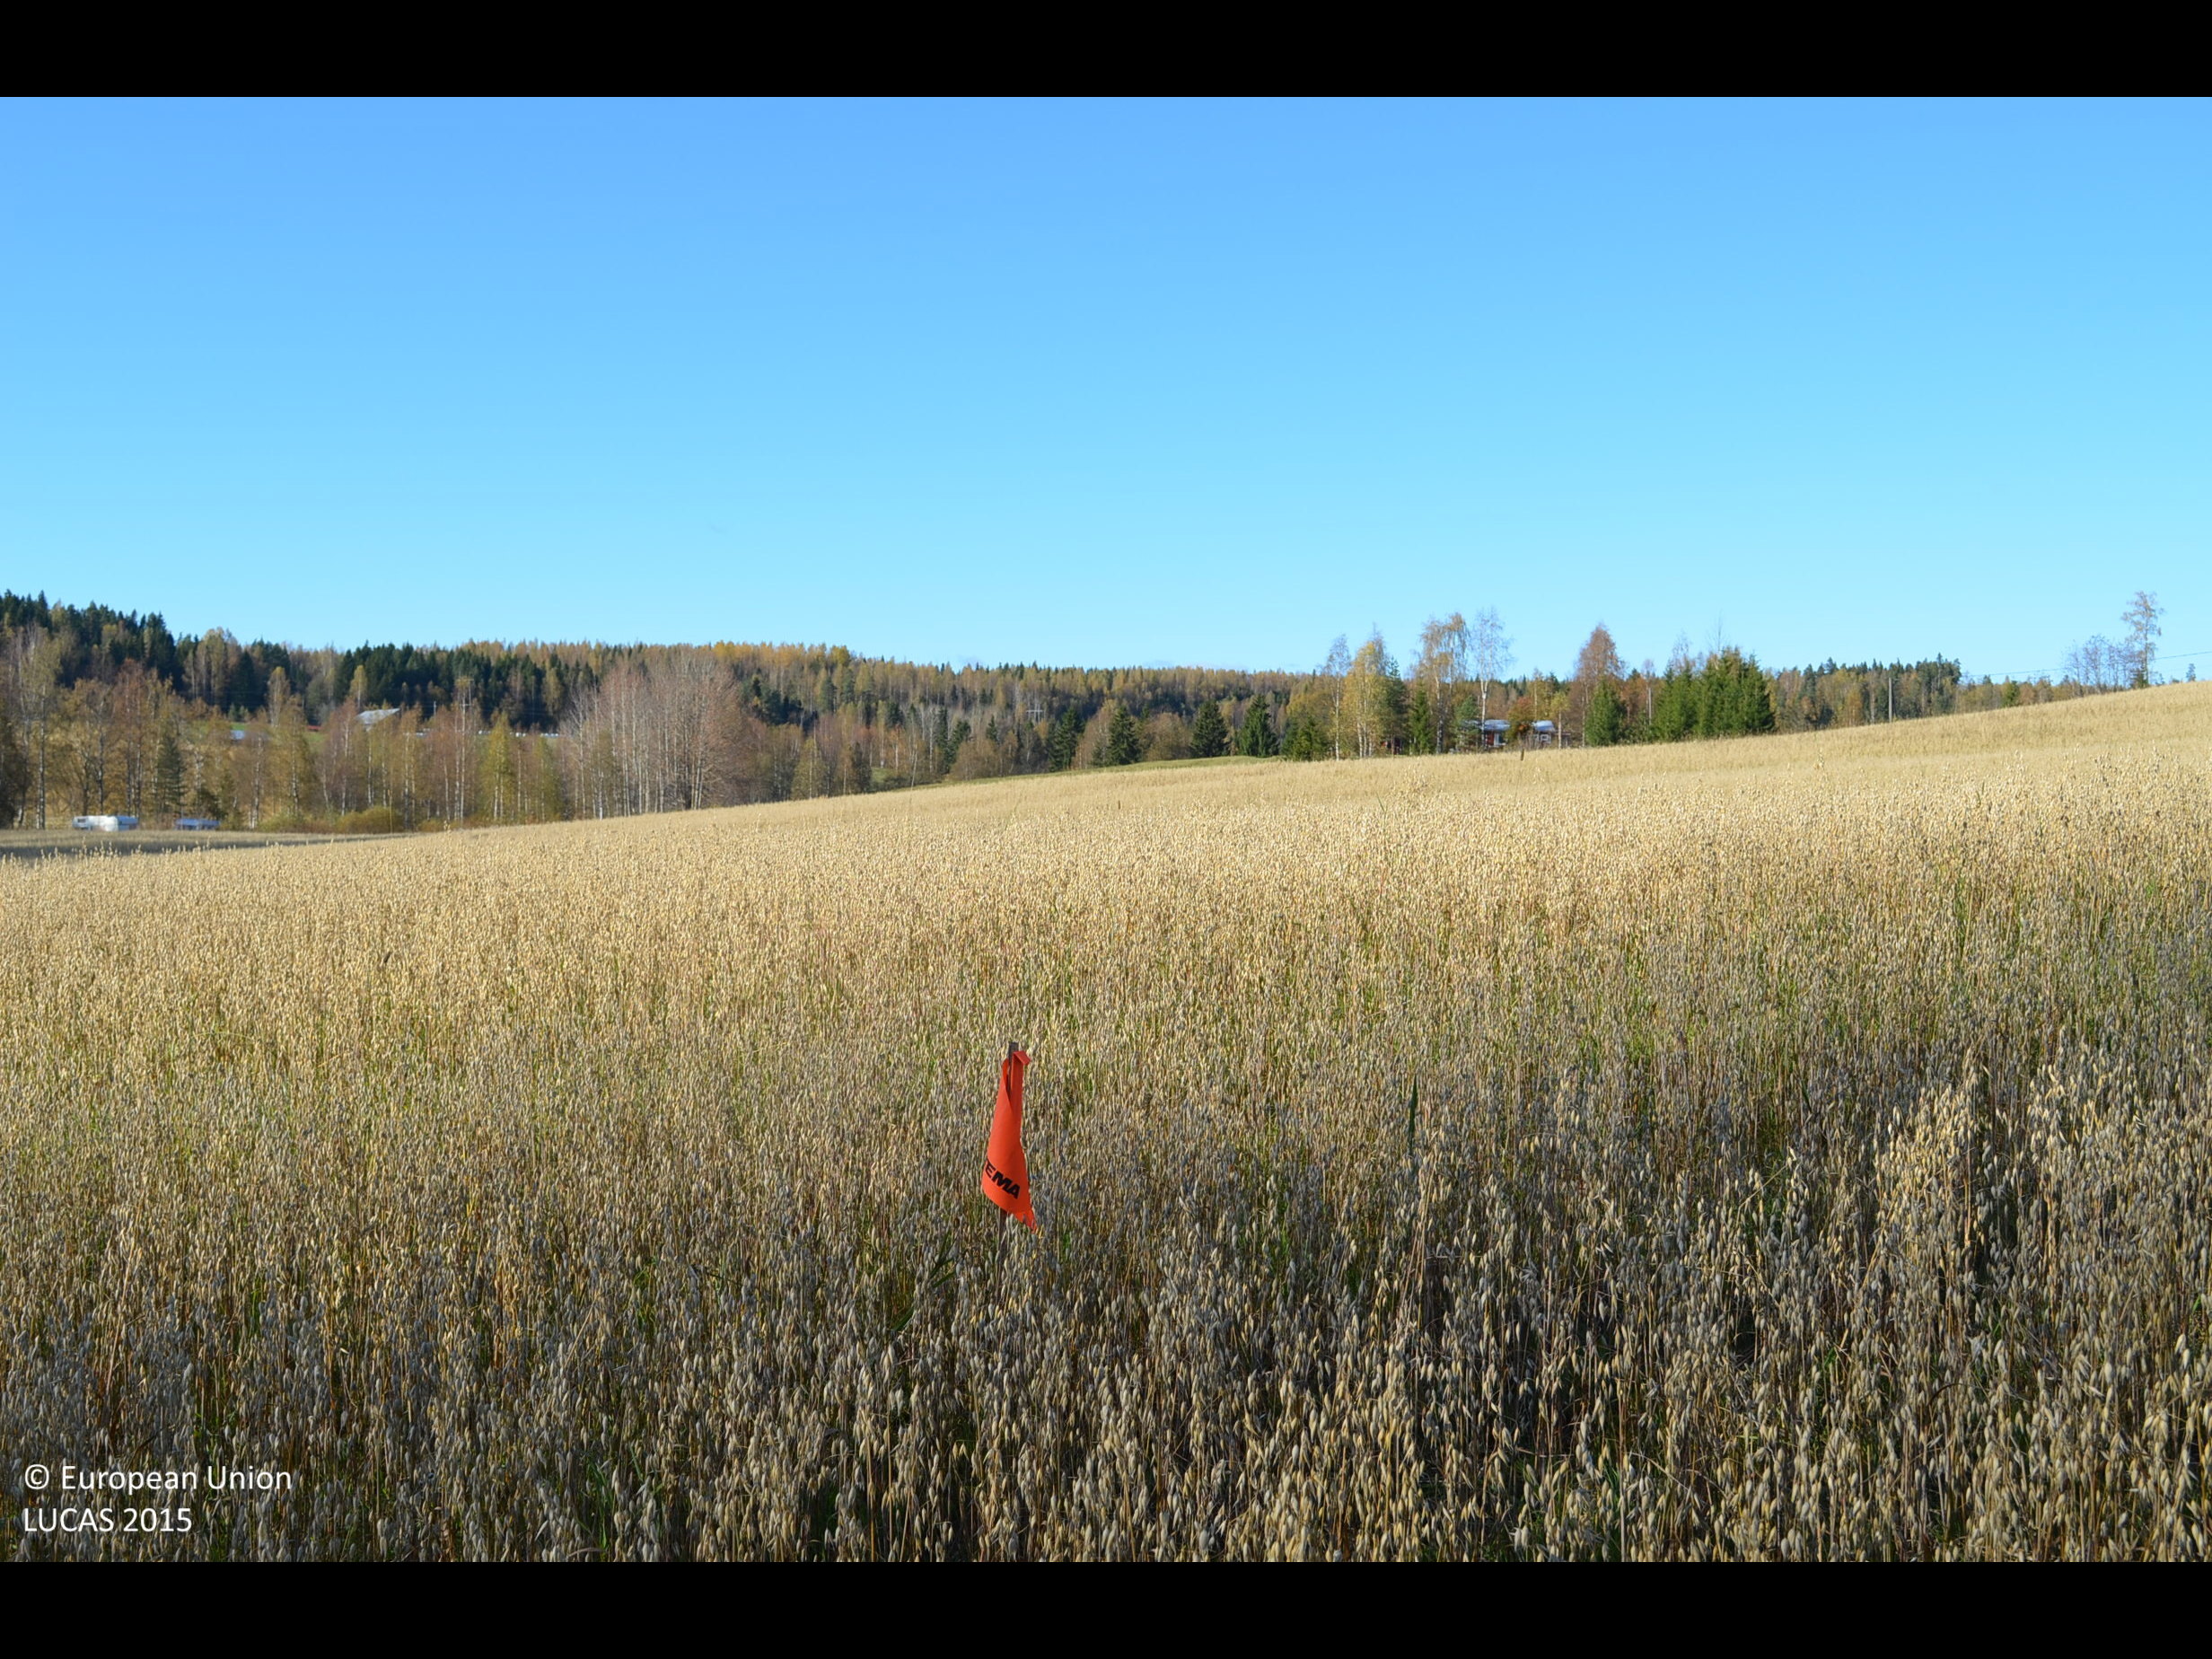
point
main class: Cropland
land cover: Oats
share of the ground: > 75 %
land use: Agriculture (excluding fallow land and kitchen gardens)
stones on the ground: < 10 %
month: October
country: FI
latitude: 61.6448
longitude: 23.3827
